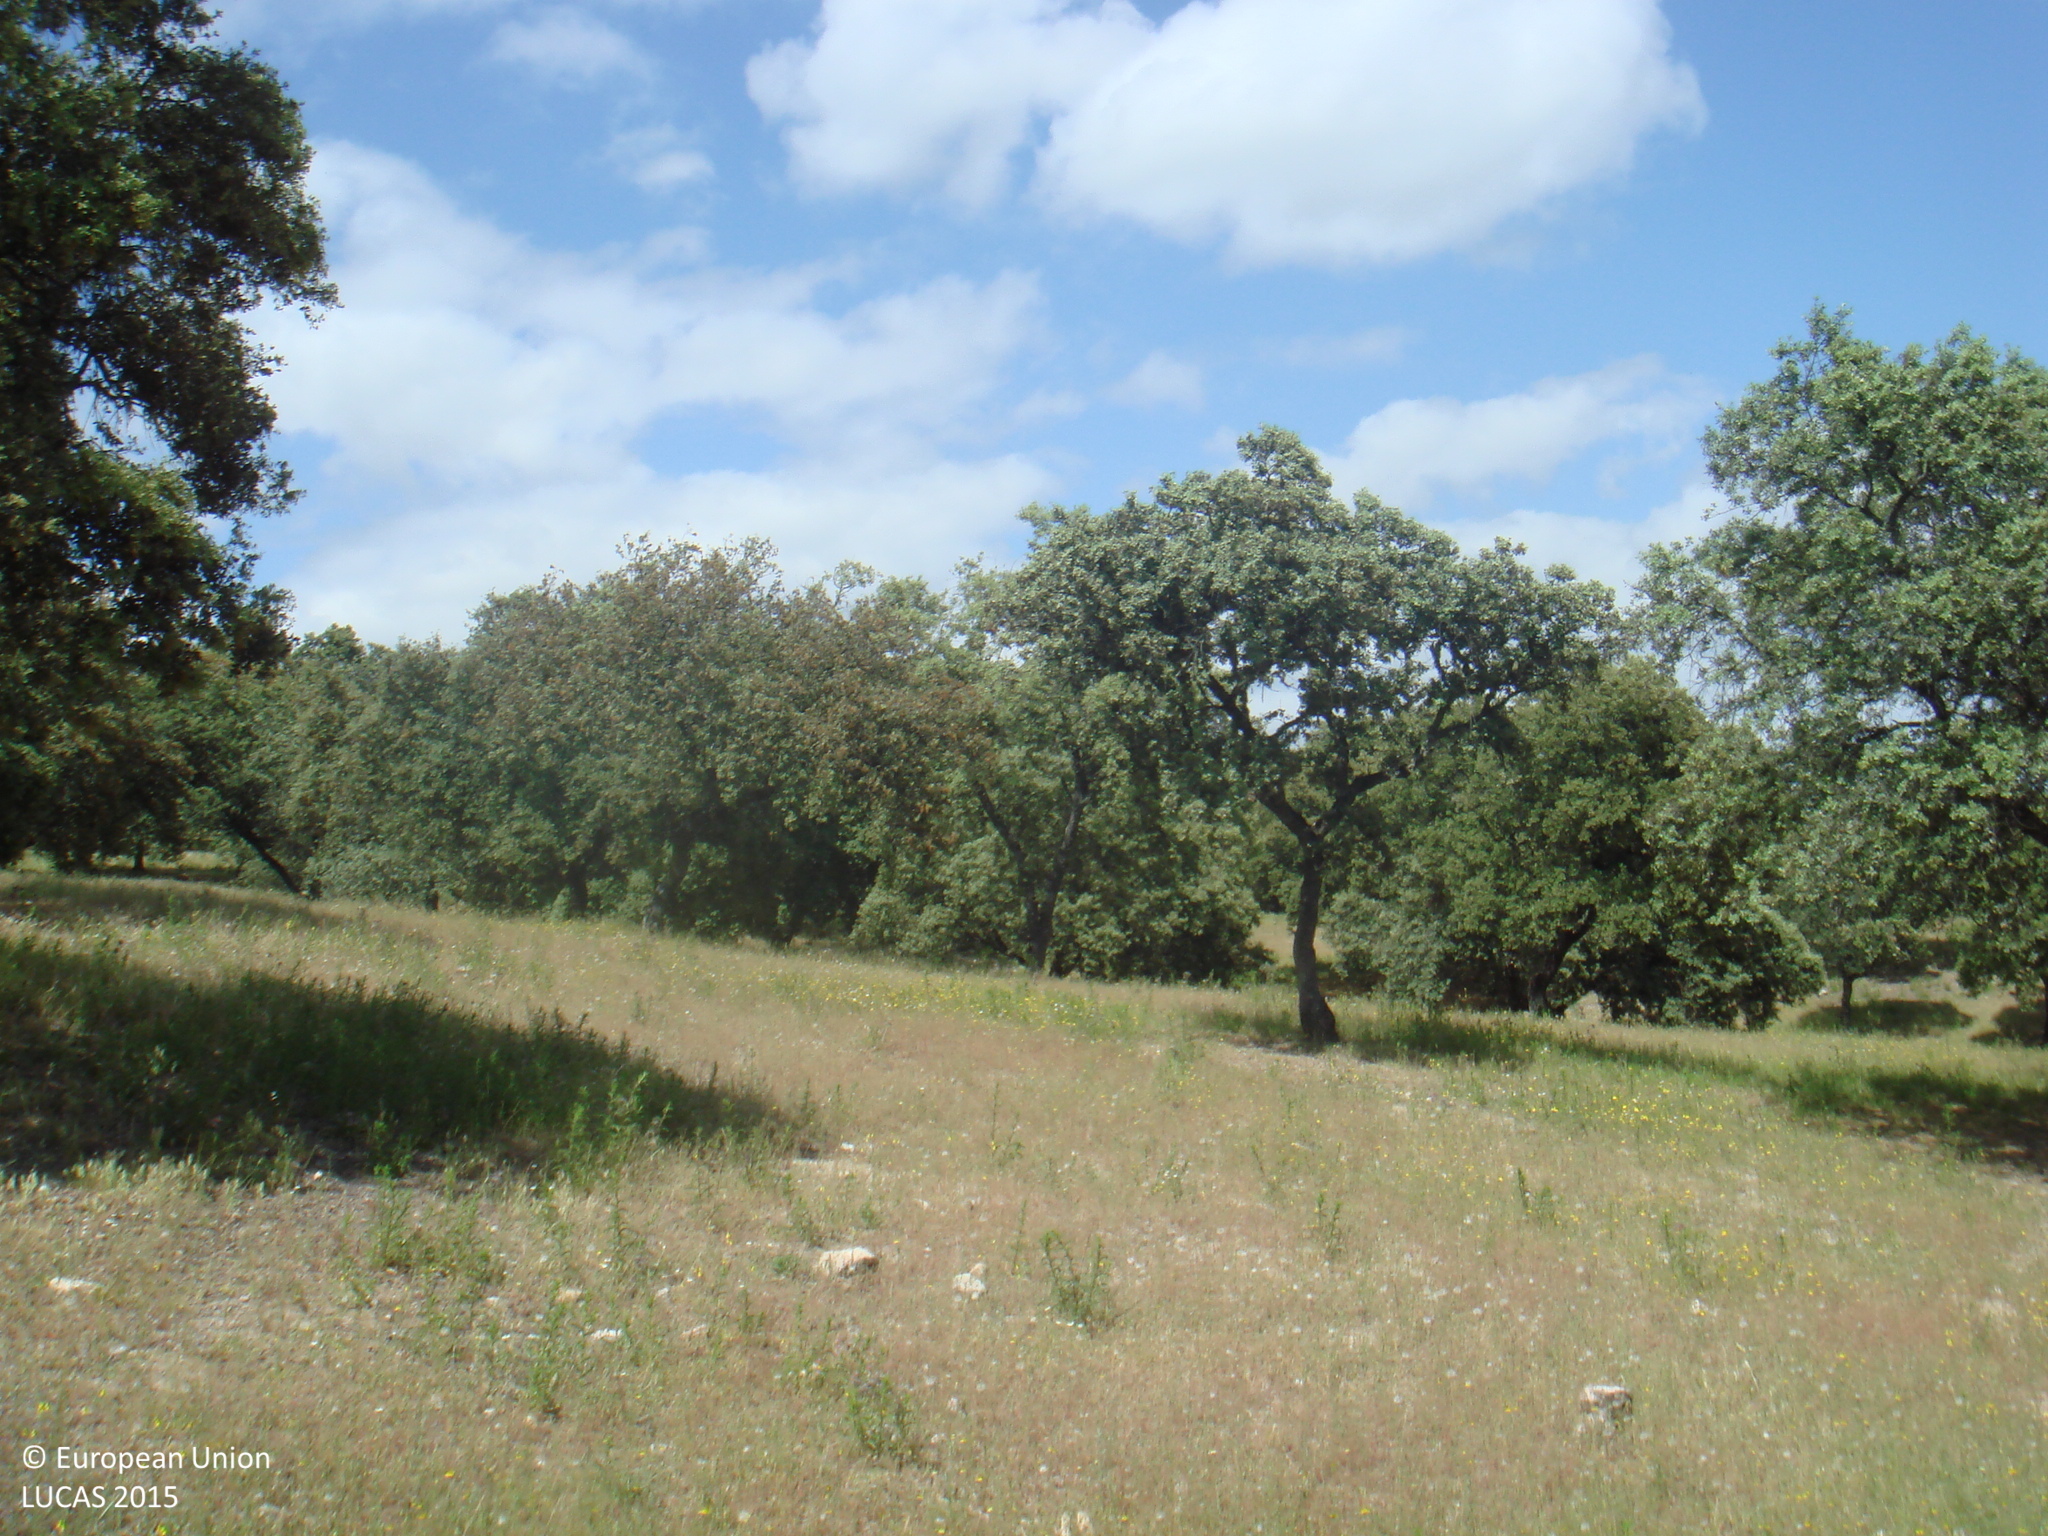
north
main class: Woodland
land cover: Broadleaved woodland
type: broadleaved evergreen forest
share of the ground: 25 - 50 %
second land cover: Spontaneously vegetated surfaces
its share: > 75 %
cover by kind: herbaceous plants 60 %, broadleaved forest trees 40 %
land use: Forestry
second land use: Agriculture (excluding fallow land and kitchen gardens)
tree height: > 5 m
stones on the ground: < 10 %
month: May
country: ES
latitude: 38.3399
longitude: -4.3749
